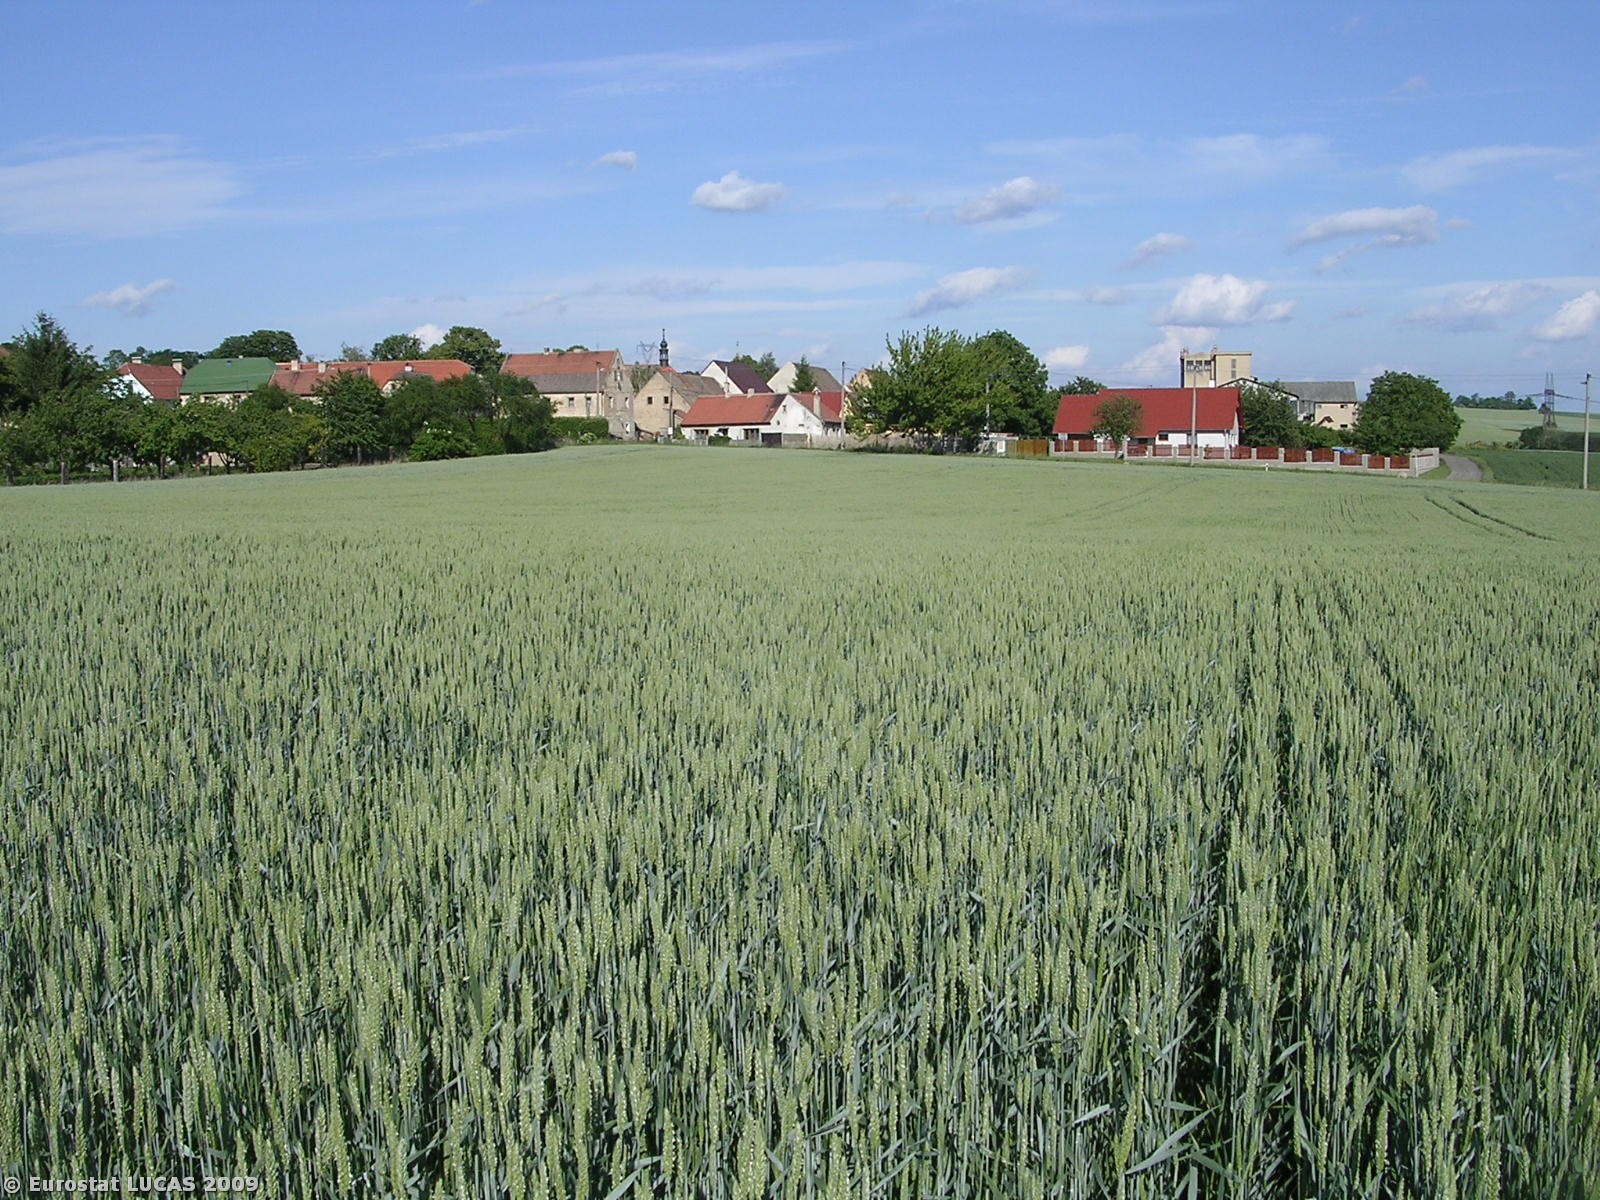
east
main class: Cropland
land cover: Common wheat
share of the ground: > 75 %
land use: Agriculture (excluding fallow land and kitchen gardens)
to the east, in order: Common wheat; Grass margins; Electric lines; Grass margins; Paved roads, cycling and walking lanes; Artificial constructions in urban areas
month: June
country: CZ
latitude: 50.5183
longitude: 14.2749
